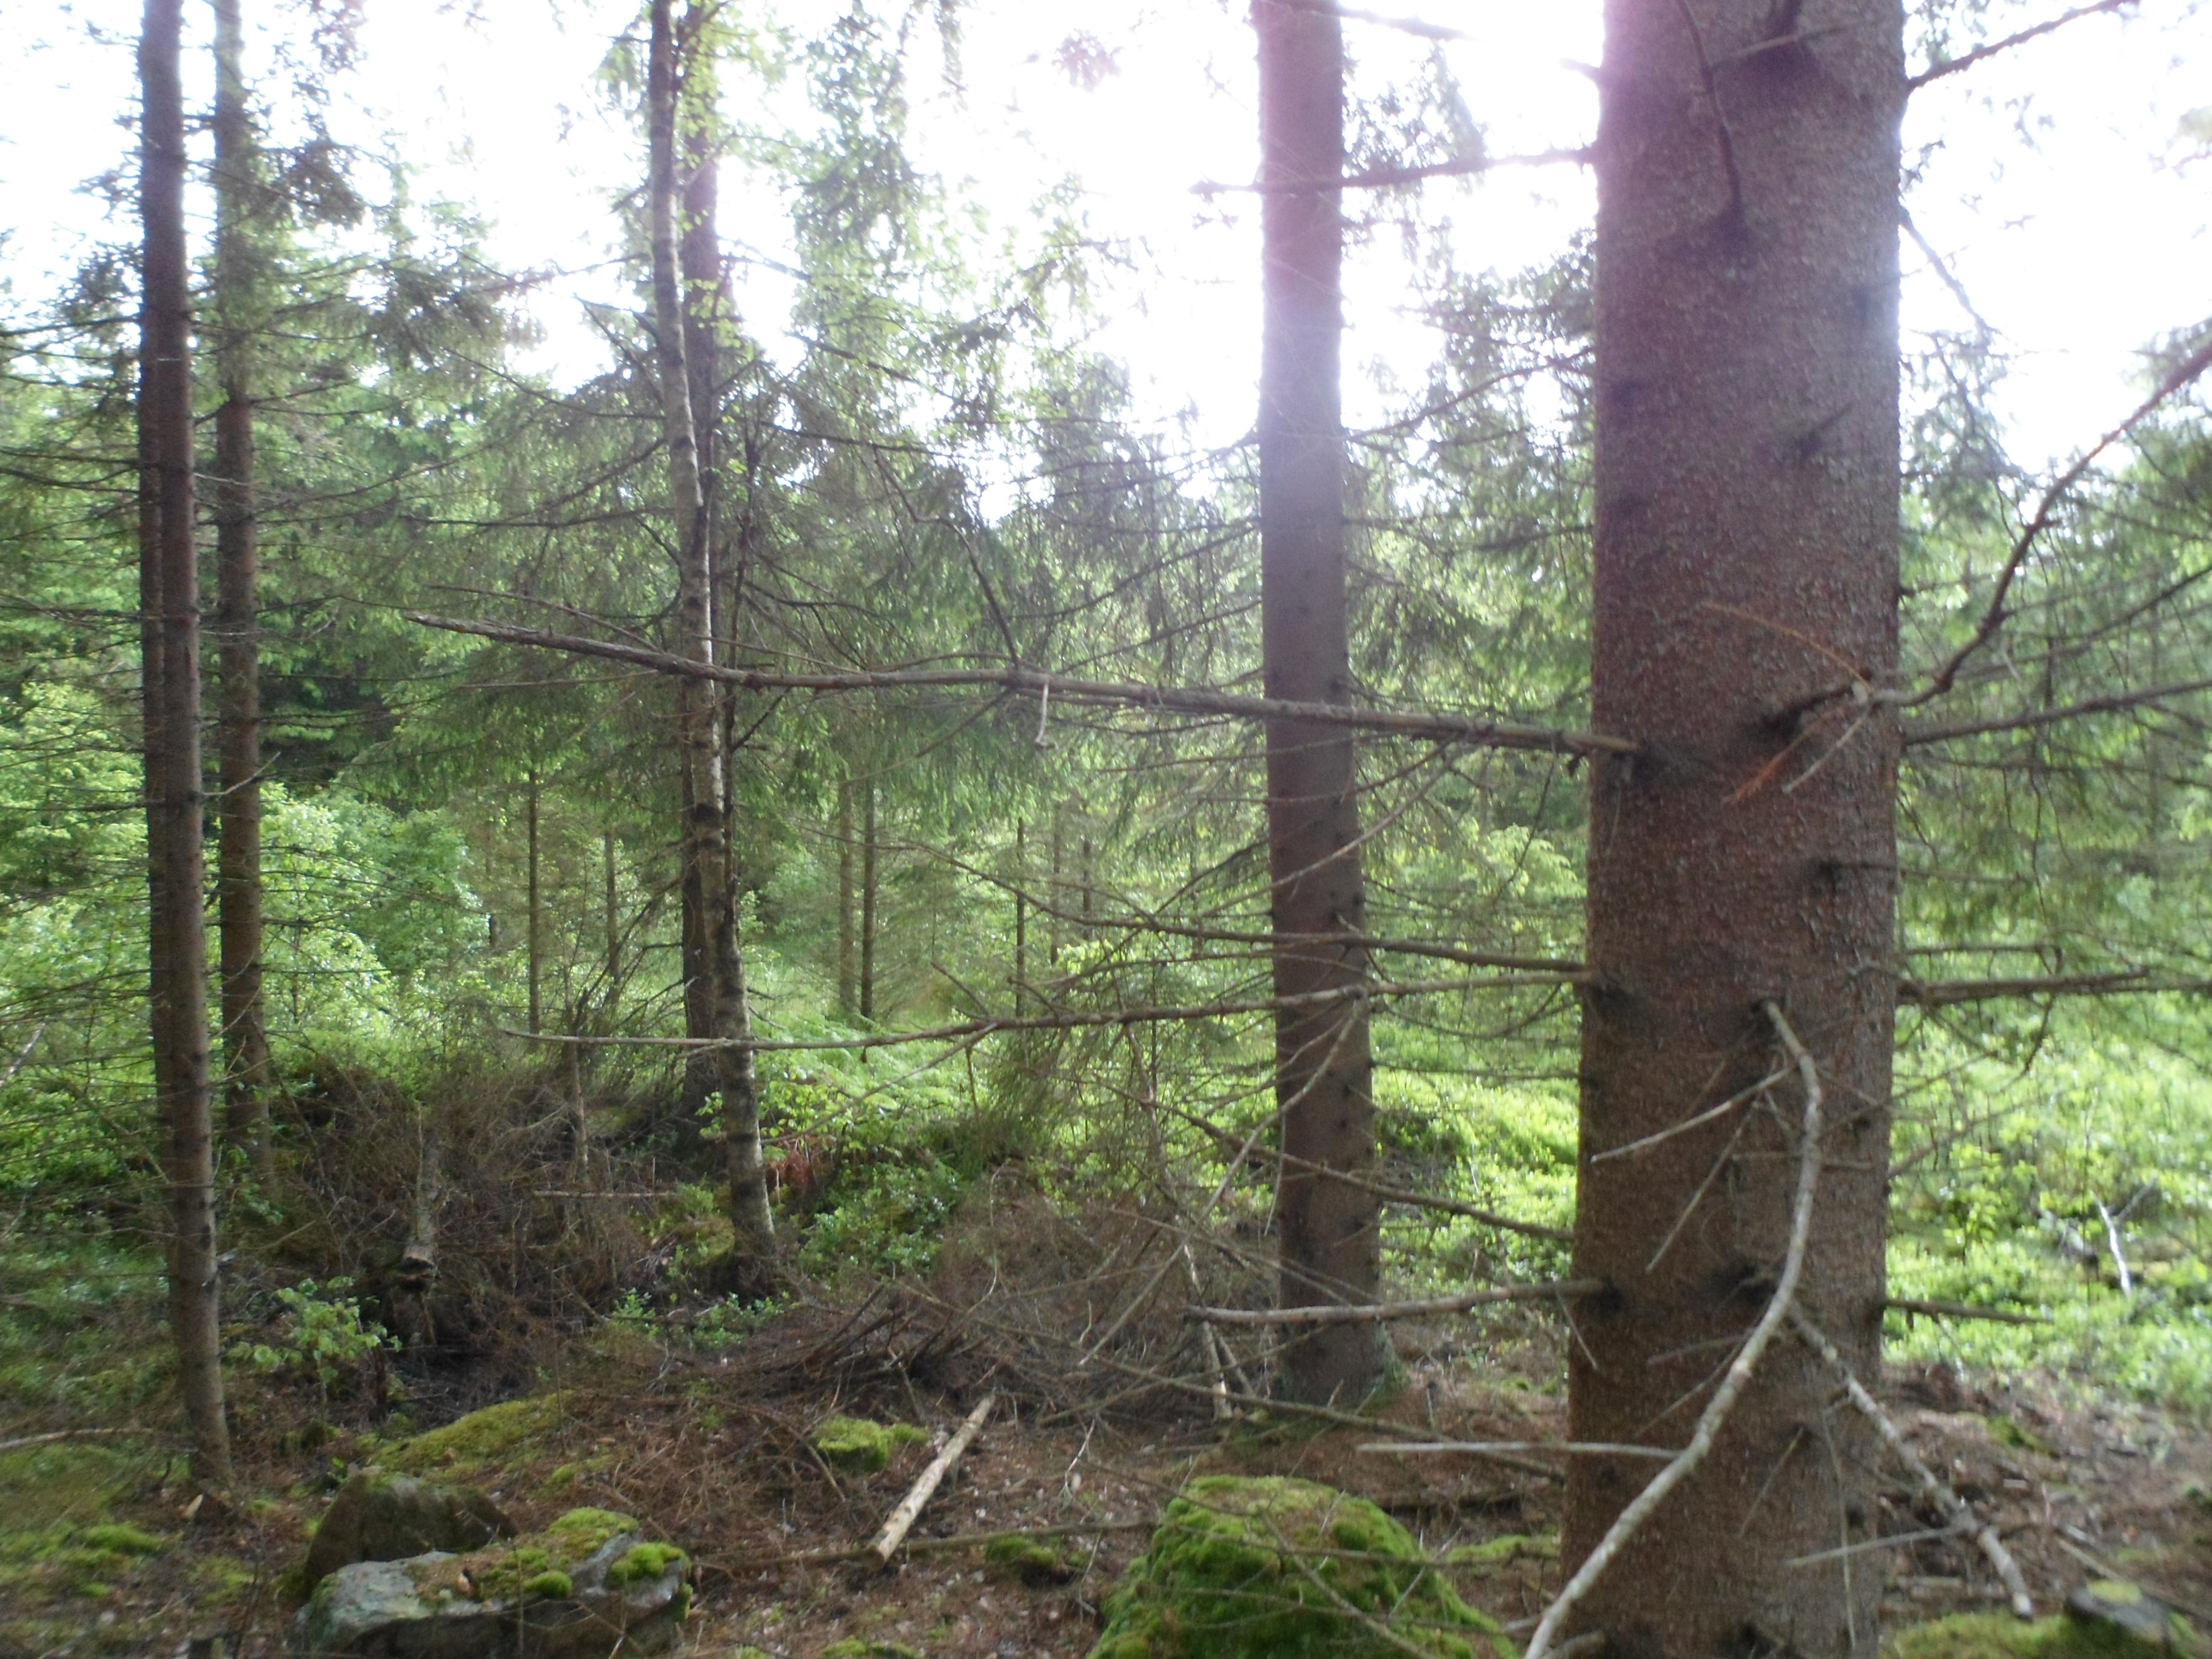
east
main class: Woodland
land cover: Spruce dominated coniferous woodland
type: boreal forest
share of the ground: > 75 %
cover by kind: coniferous forest trees 75 %, lichens and mosses 15 %, unconsolidated bare surface 10 %
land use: Forestry
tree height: > 5 m
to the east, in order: Spruce dominated coniferous woodland; Ditches and canals; Spruce dominated coniferous woodland
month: June
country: SE
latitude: 56.8896
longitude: 14.3136
